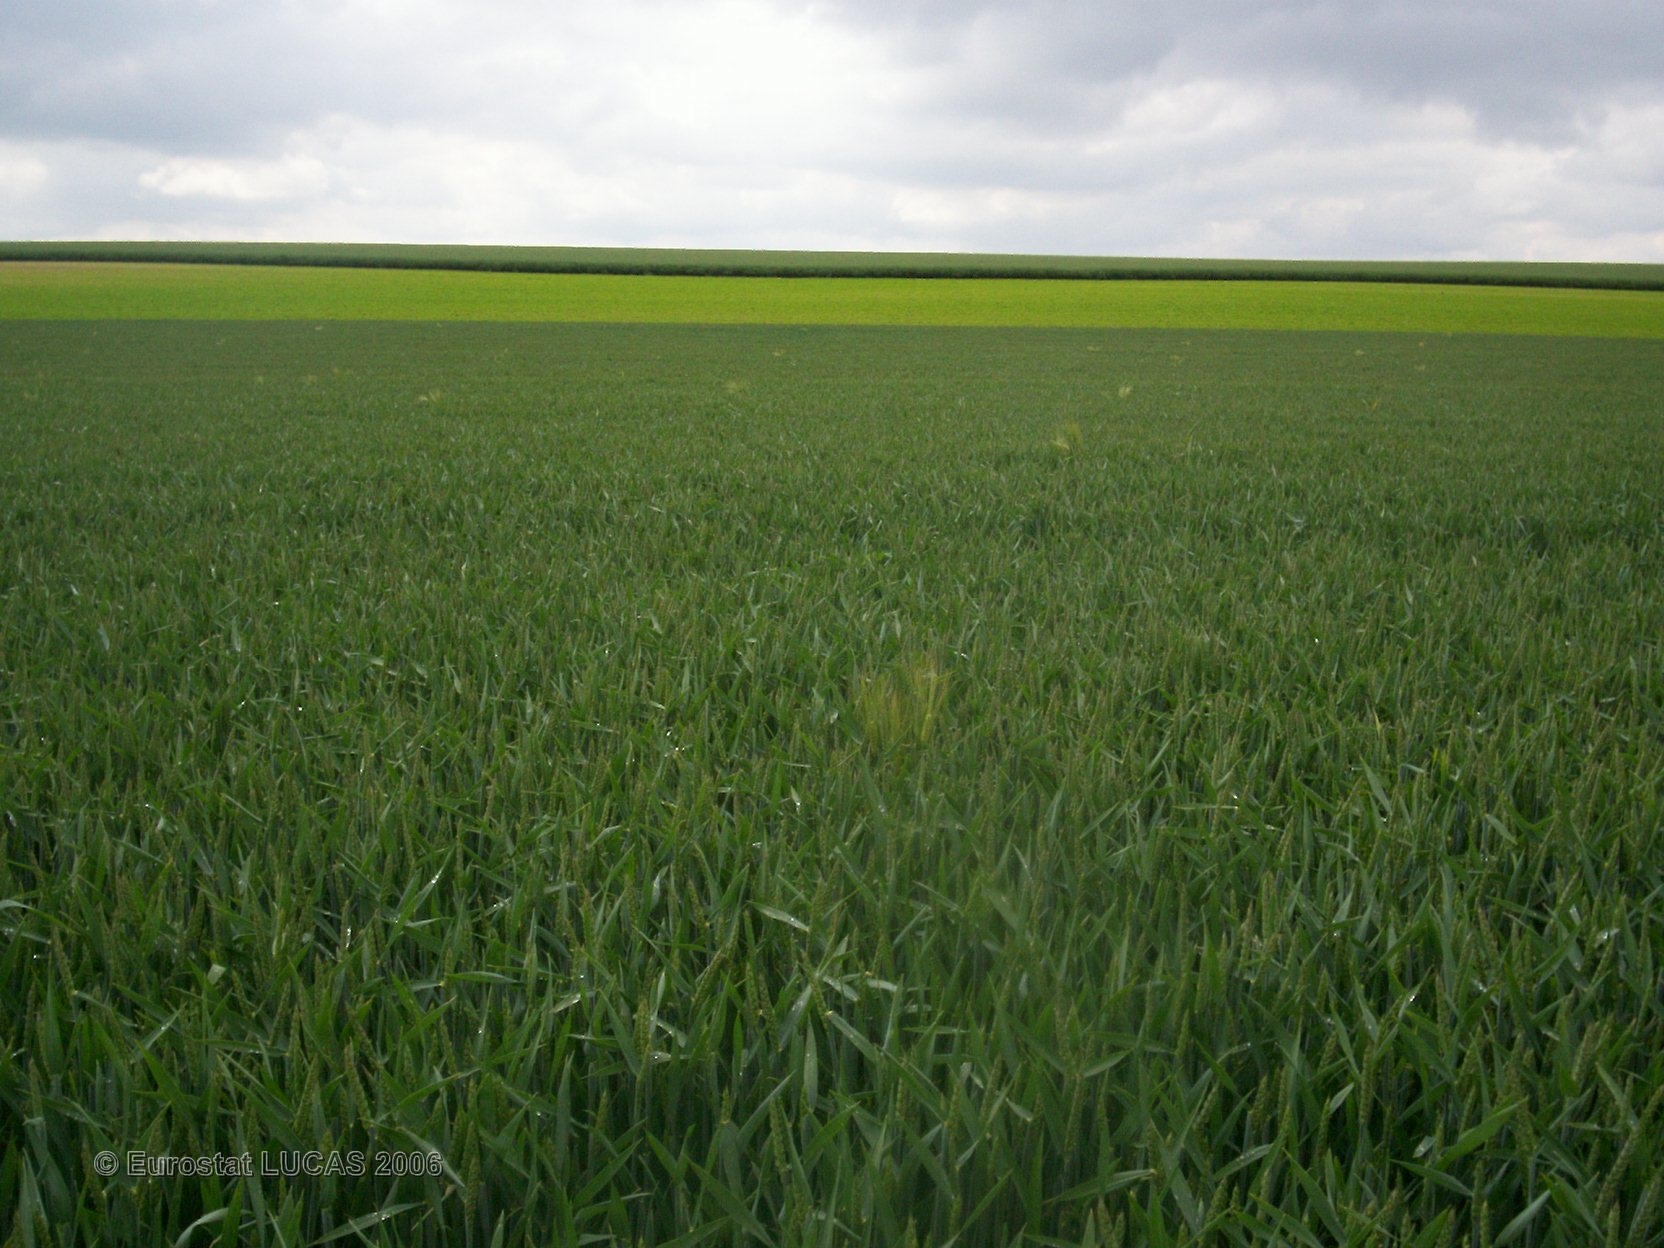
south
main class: Cropland
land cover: Common wheat
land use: Agriculture (excluding fallow land and kitchen gardens)
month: June
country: FR
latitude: 48.5902
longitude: 4.4790
